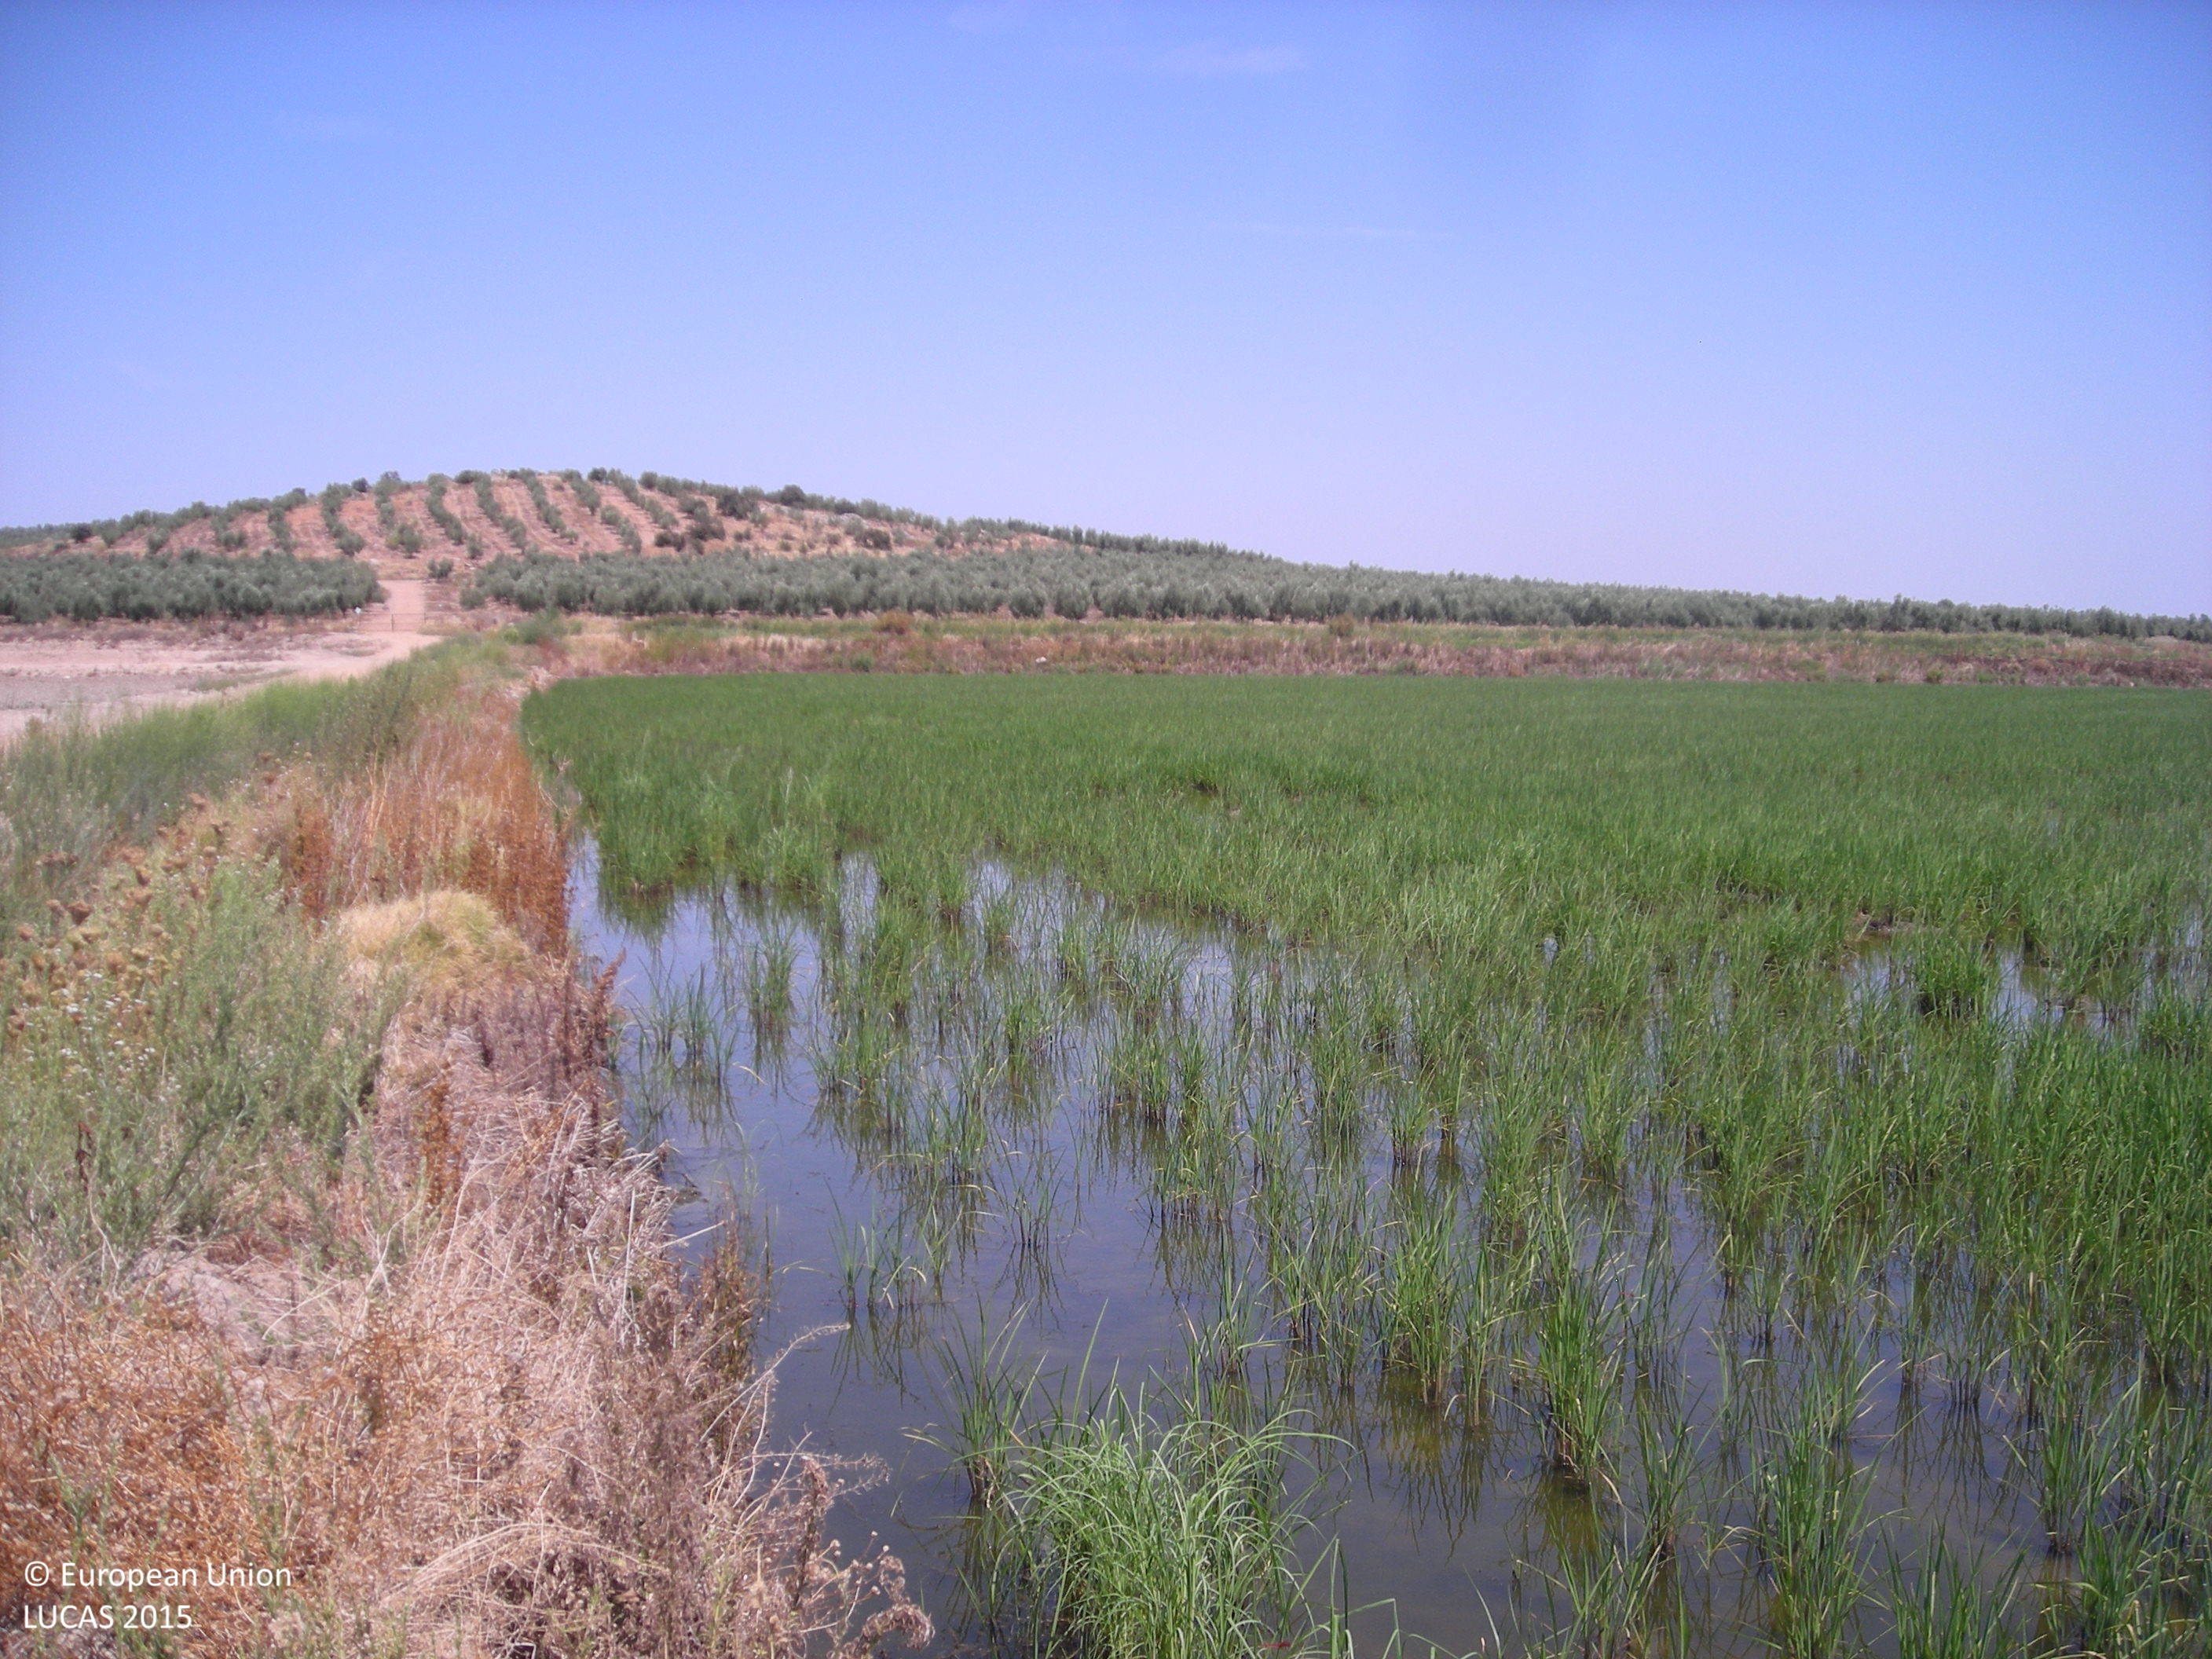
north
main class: Cropland
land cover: Rice
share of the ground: > 75 %
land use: Agriculture (excluding fallow land and kitchen gardens)
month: July
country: ES
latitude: 39.0215
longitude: -5.9803
